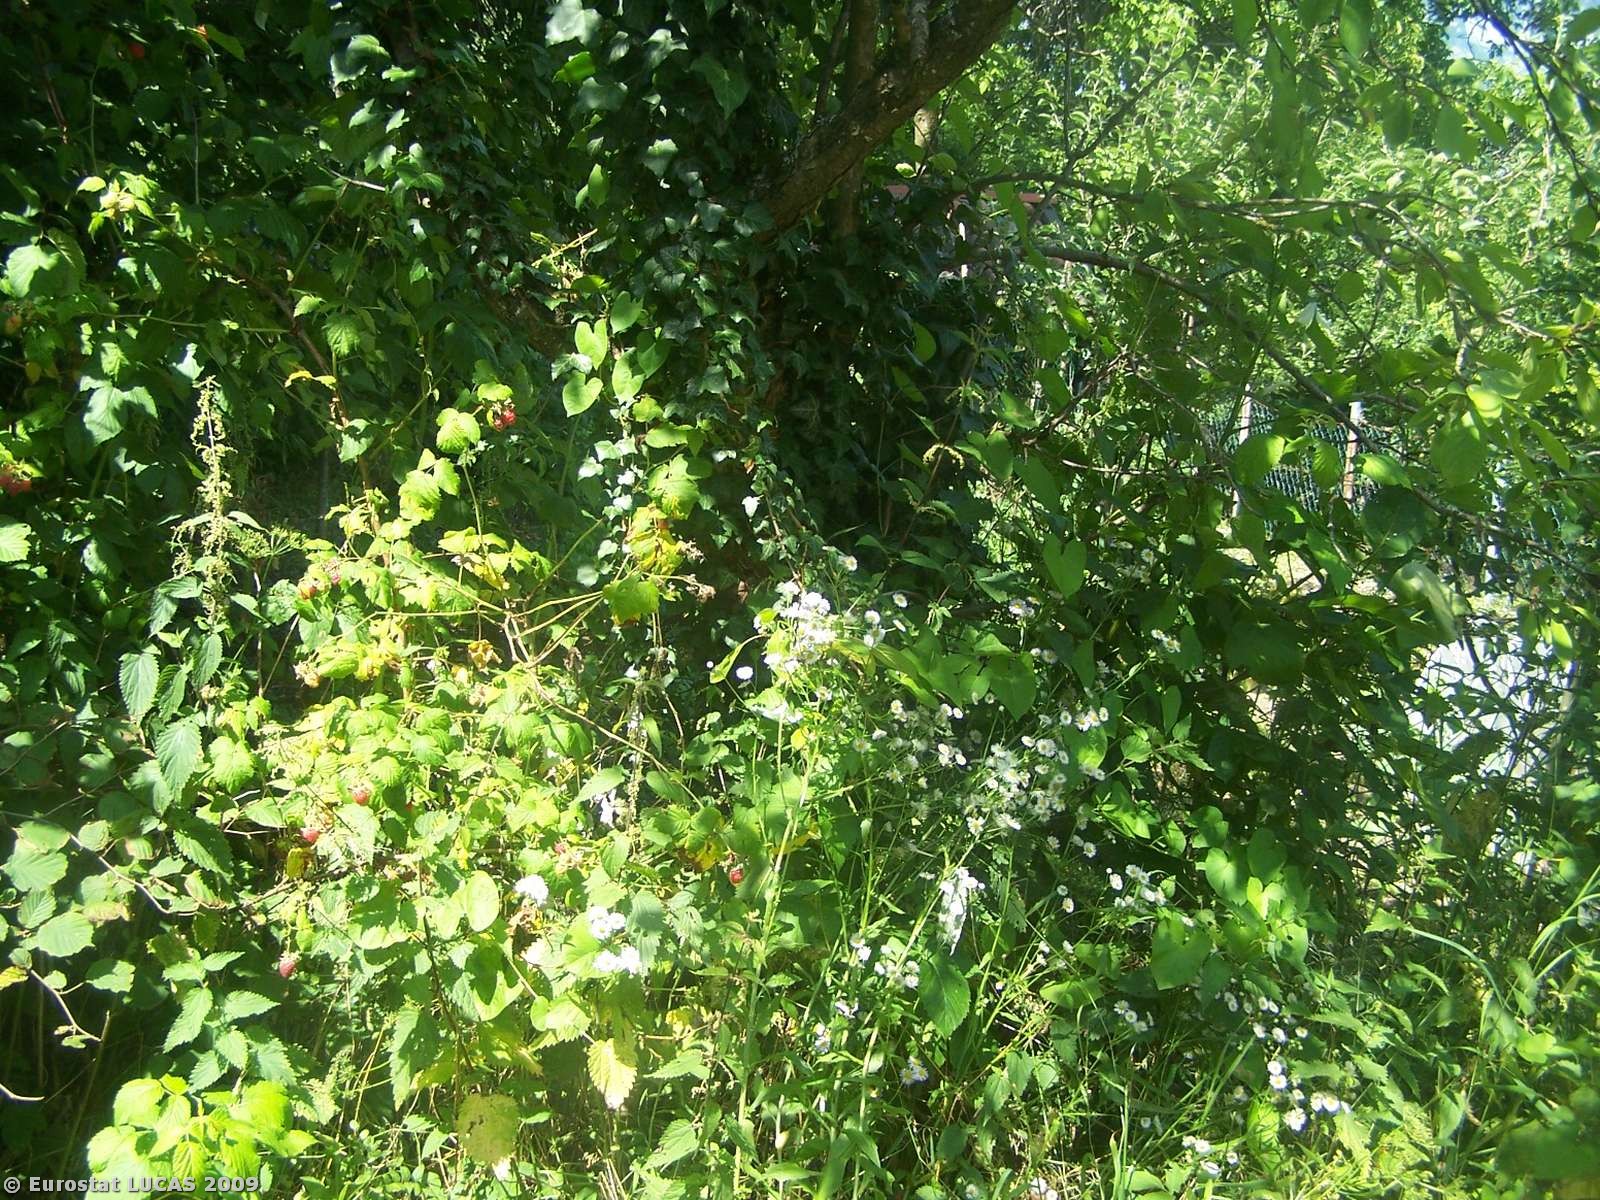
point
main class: Cropland
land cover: Nuts trees
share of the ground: 25 - 50 %
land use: Kitchen garden
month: July
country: IT
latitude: 46.4712
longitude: 13.0054
